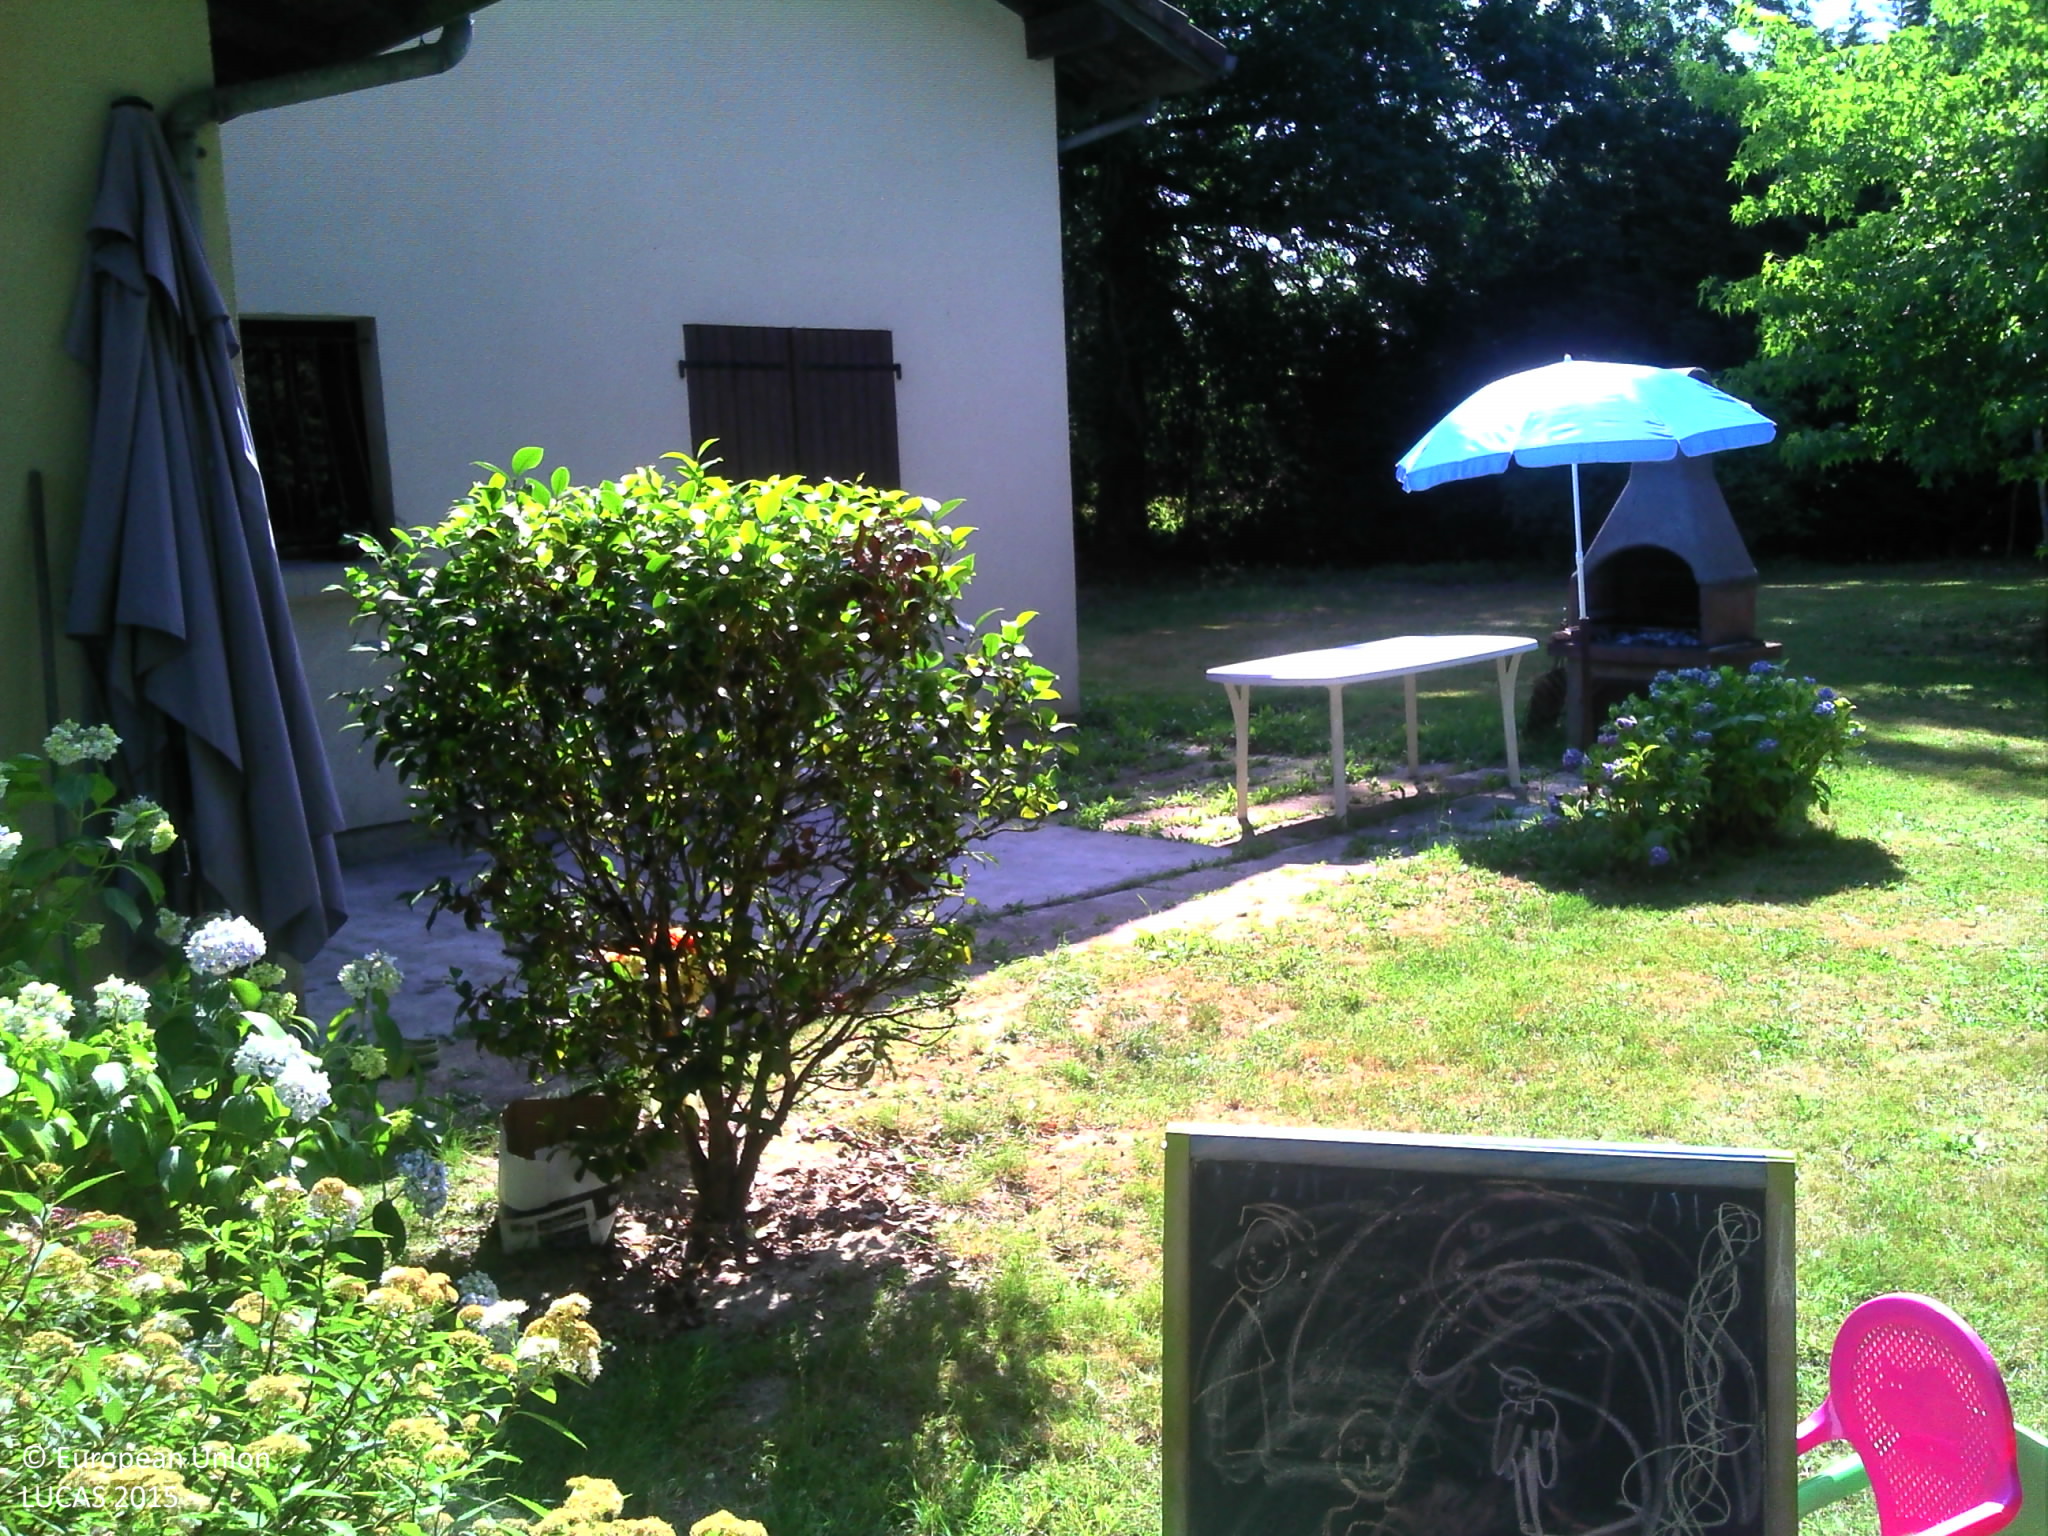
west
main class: Grassland
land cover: Grassland with sparse tree/shrub cover
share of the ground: > 75 %
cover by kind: herbaceous plants 95 %, broadleaved forest trees 5 %
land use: Residential
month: June
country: FR
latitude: 43.8351
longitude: -0.4954
